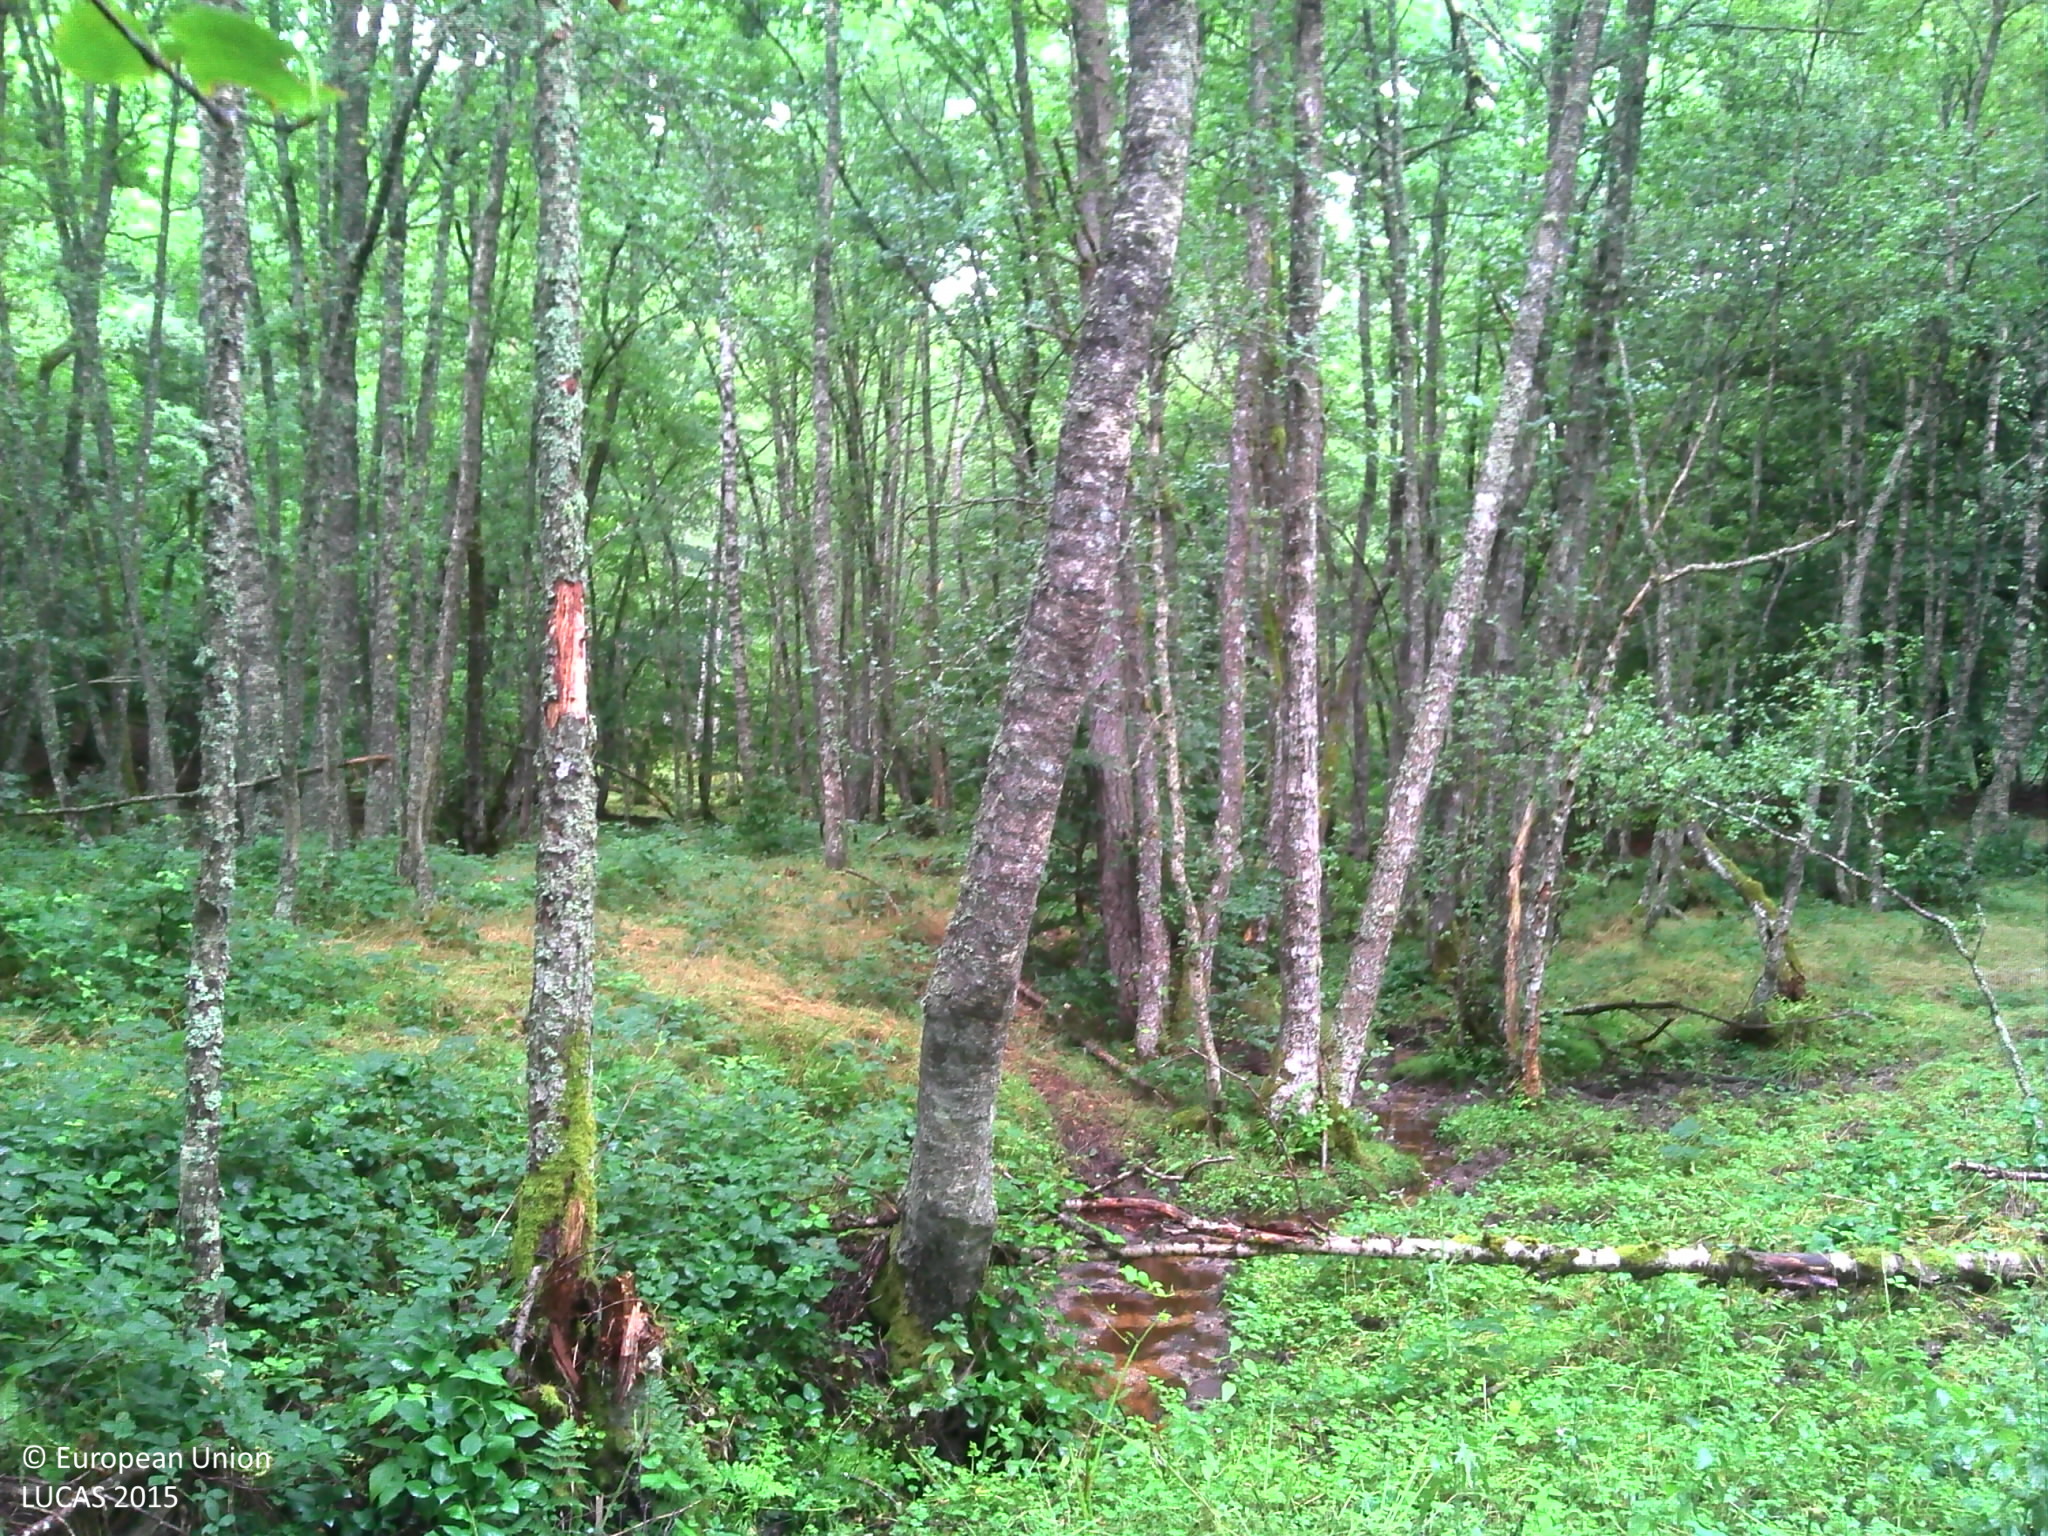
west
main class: Woodland
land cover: Broadleaved woodland
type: non-riverine alder, birch or aspen forest
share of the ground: > 75 %
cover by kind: broadleaved forest trees 80 %, herbaceous plants 20 %
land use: Forestry
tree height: > 5 m
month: July
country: FR
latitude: 44.8136
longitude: 2.9088
